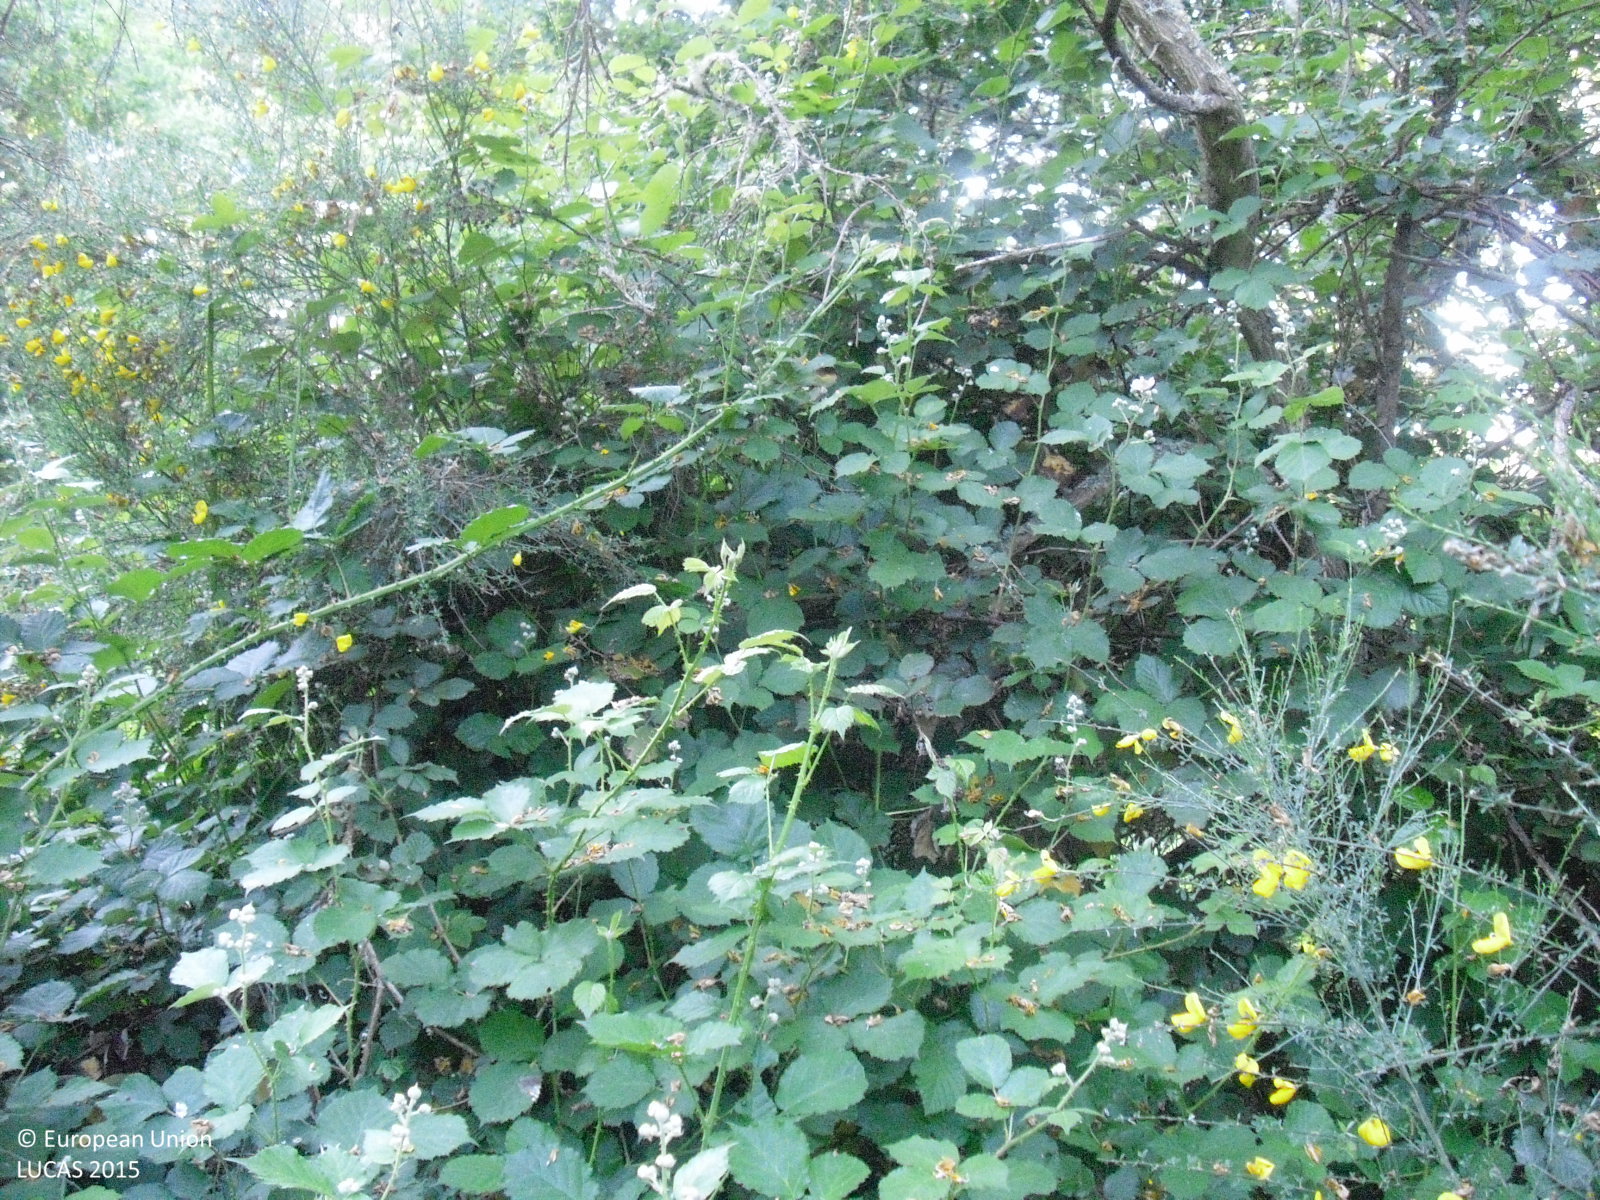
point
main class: Shrubland
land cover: Shrubland with sparse tree cover
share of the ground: > 75 %
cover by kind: shrubs 80 %, herbaceous plants 15 %, broadleaved forest trees 5 %
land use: Abandoned areas
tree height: < 5 m
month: May
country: ES
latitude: 42.2290
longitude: -7.7751
